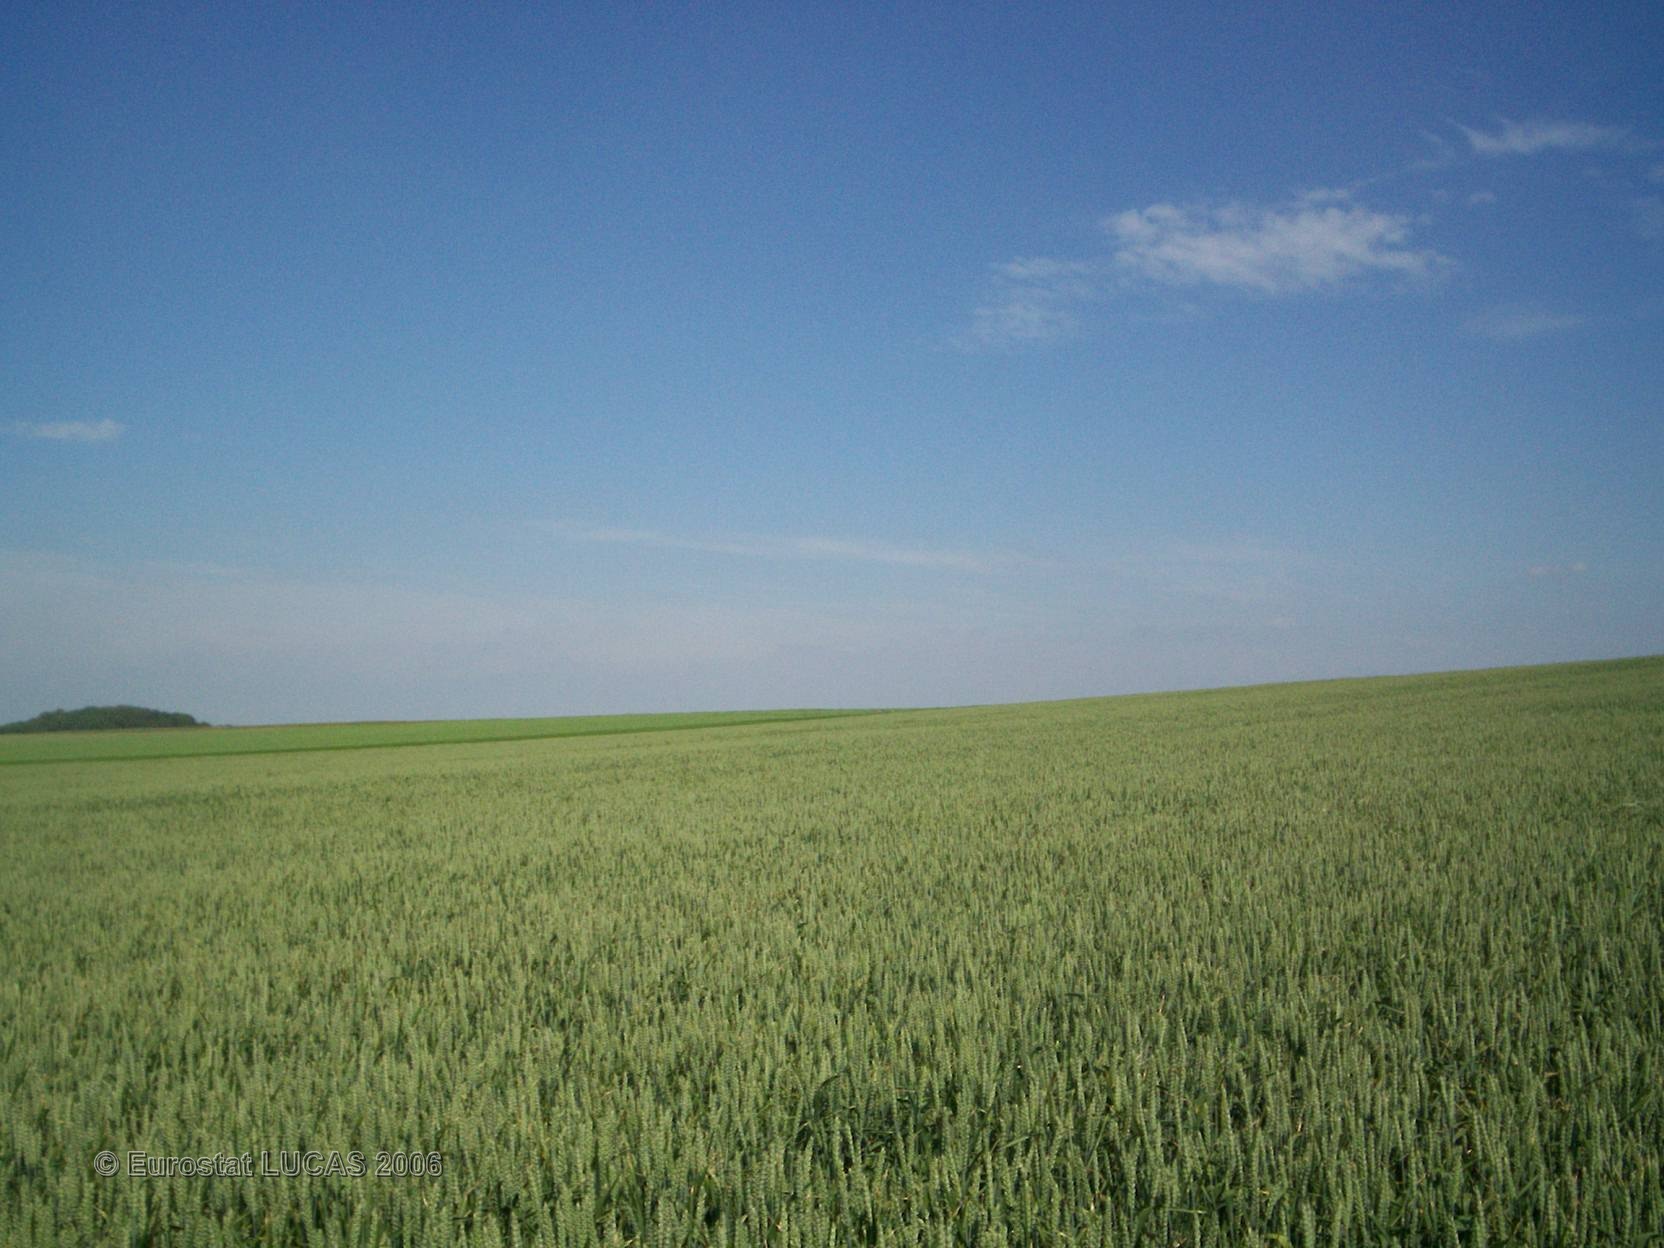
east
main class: Cropland
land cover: Common wheat
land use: Agriculture (excluding fallow land and kitchen gardens)
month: June
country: FR
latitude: 49.5674
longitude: 2.6466
